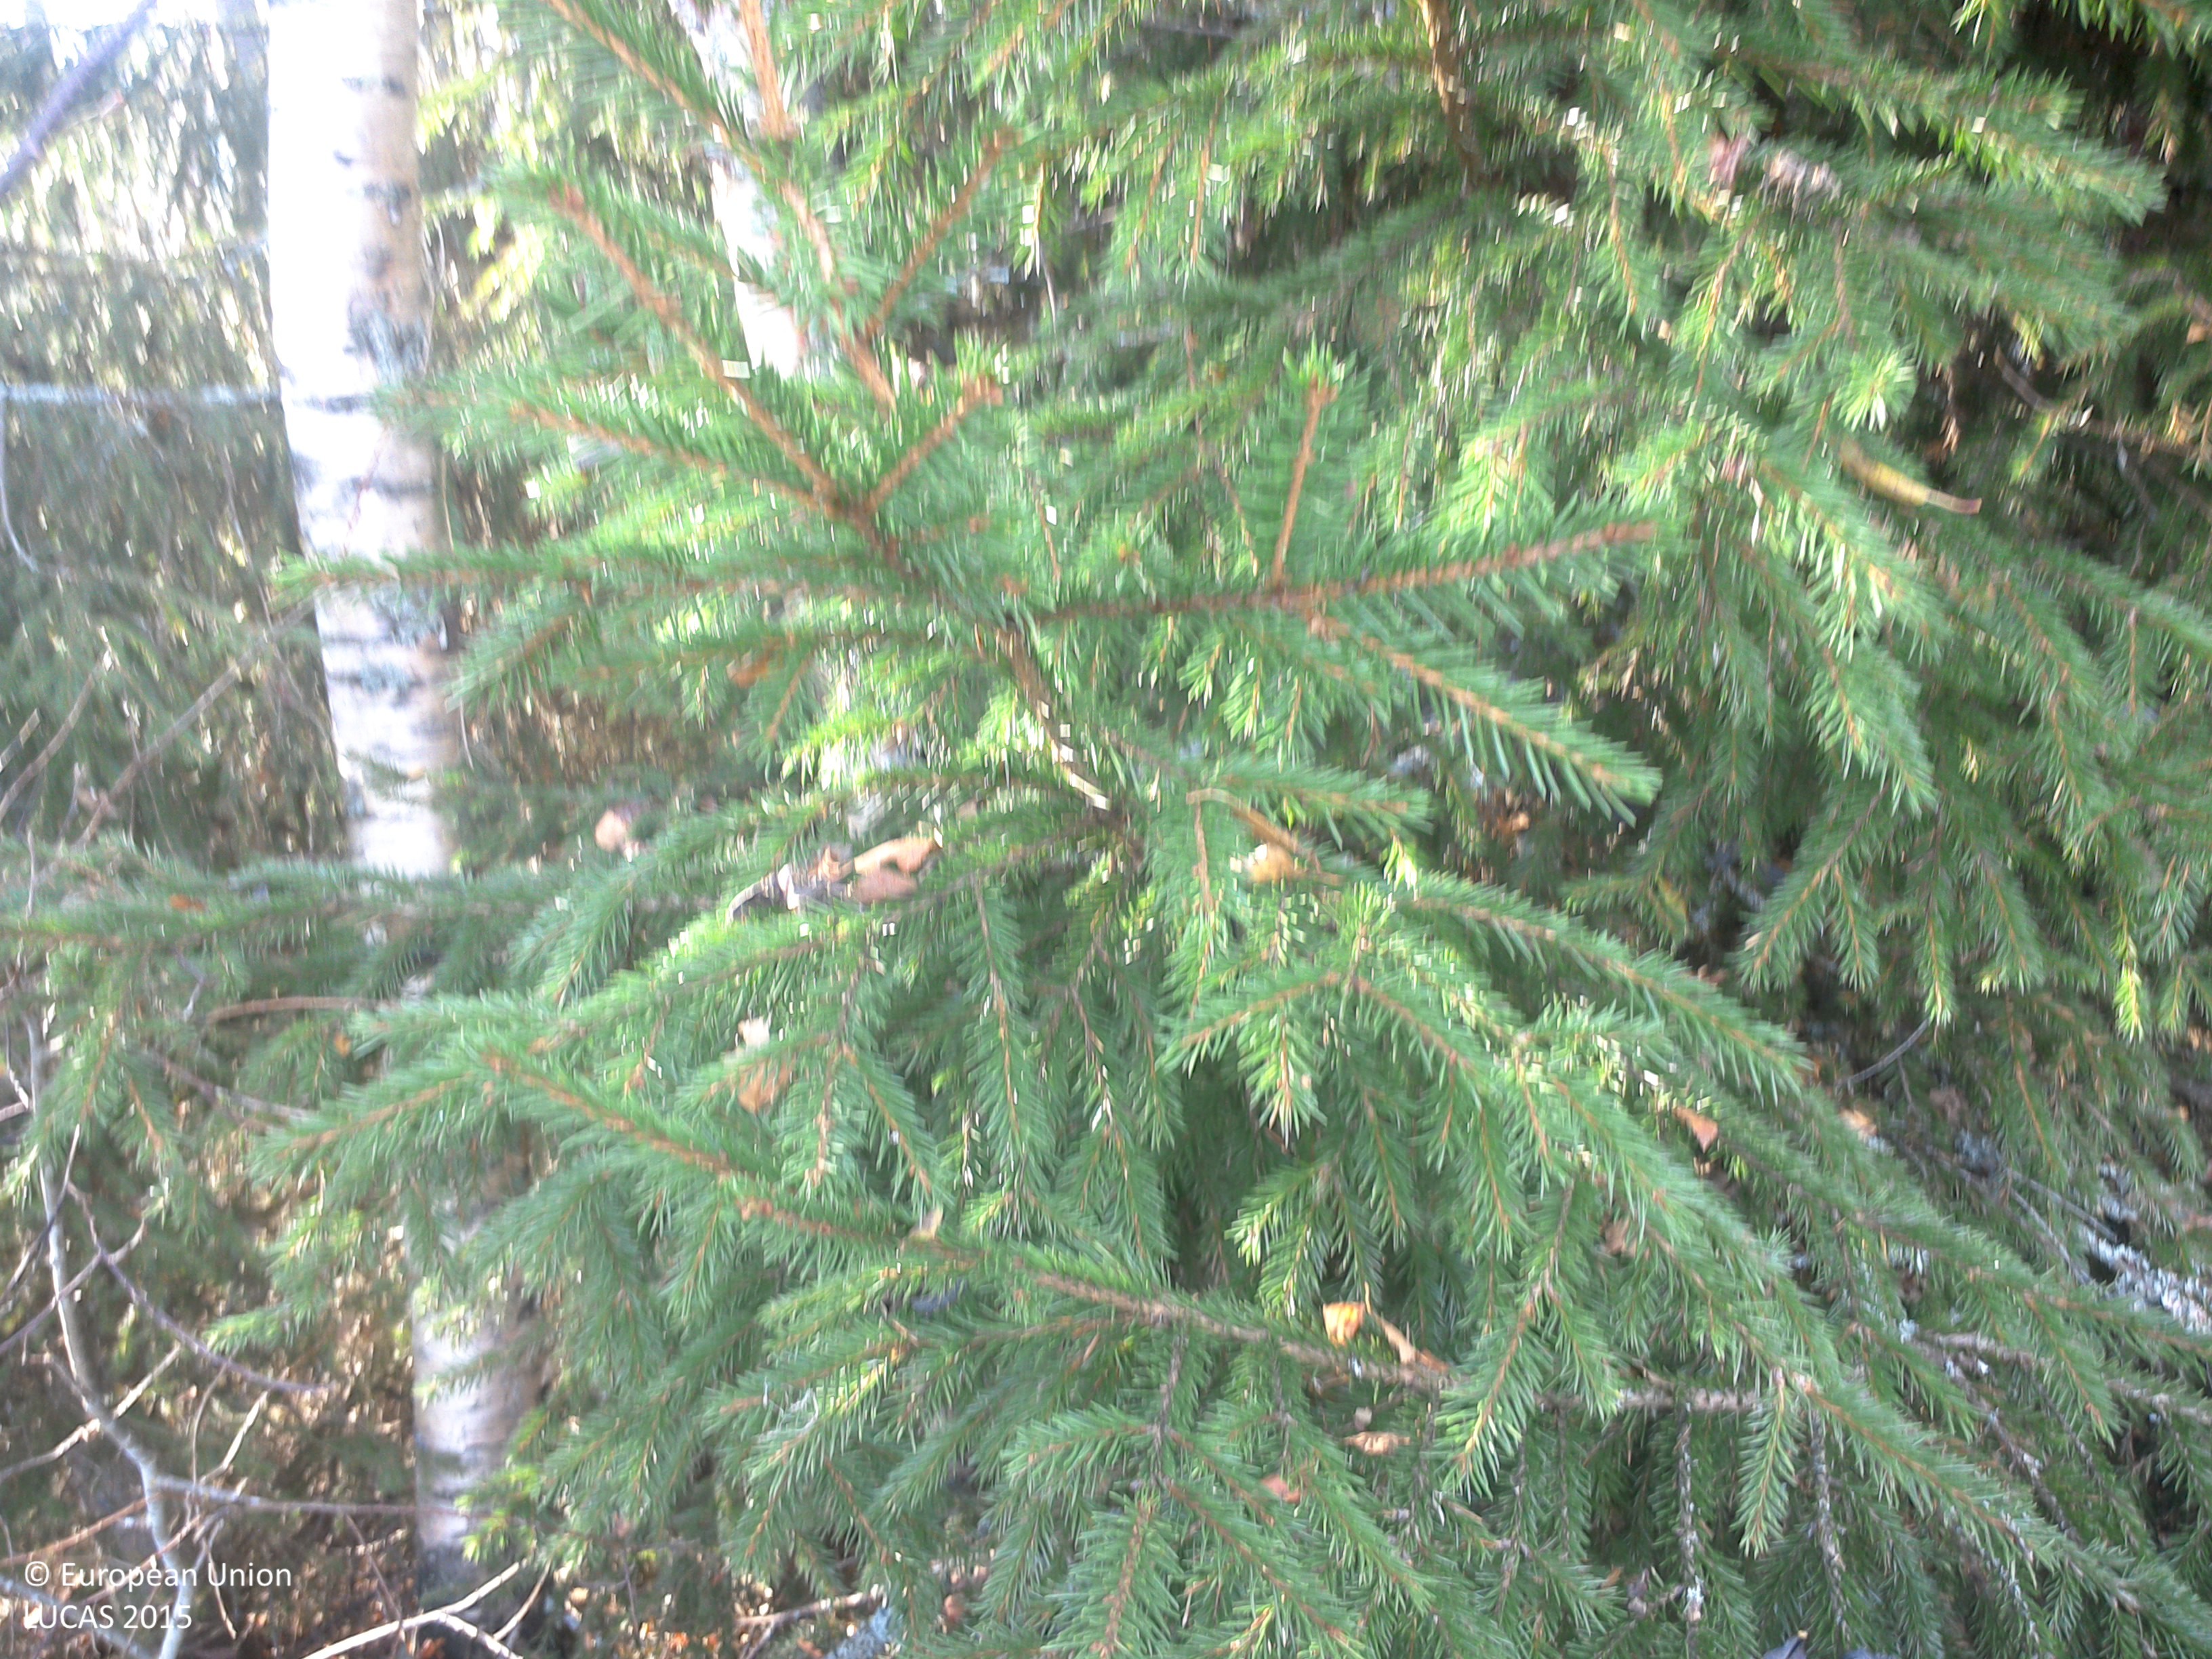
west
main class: Woodland
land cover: Spruce dominated mixed woodland
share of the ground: 50 - 75 %
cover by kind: coniferous forest trees 30 %, shrubs 25 %, herbaceous plants 25 %, broadleaved forest trees 20 %
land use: Forestry
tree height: > 5 m
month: October
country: SE
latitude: 63.8803
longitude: 19.7300
